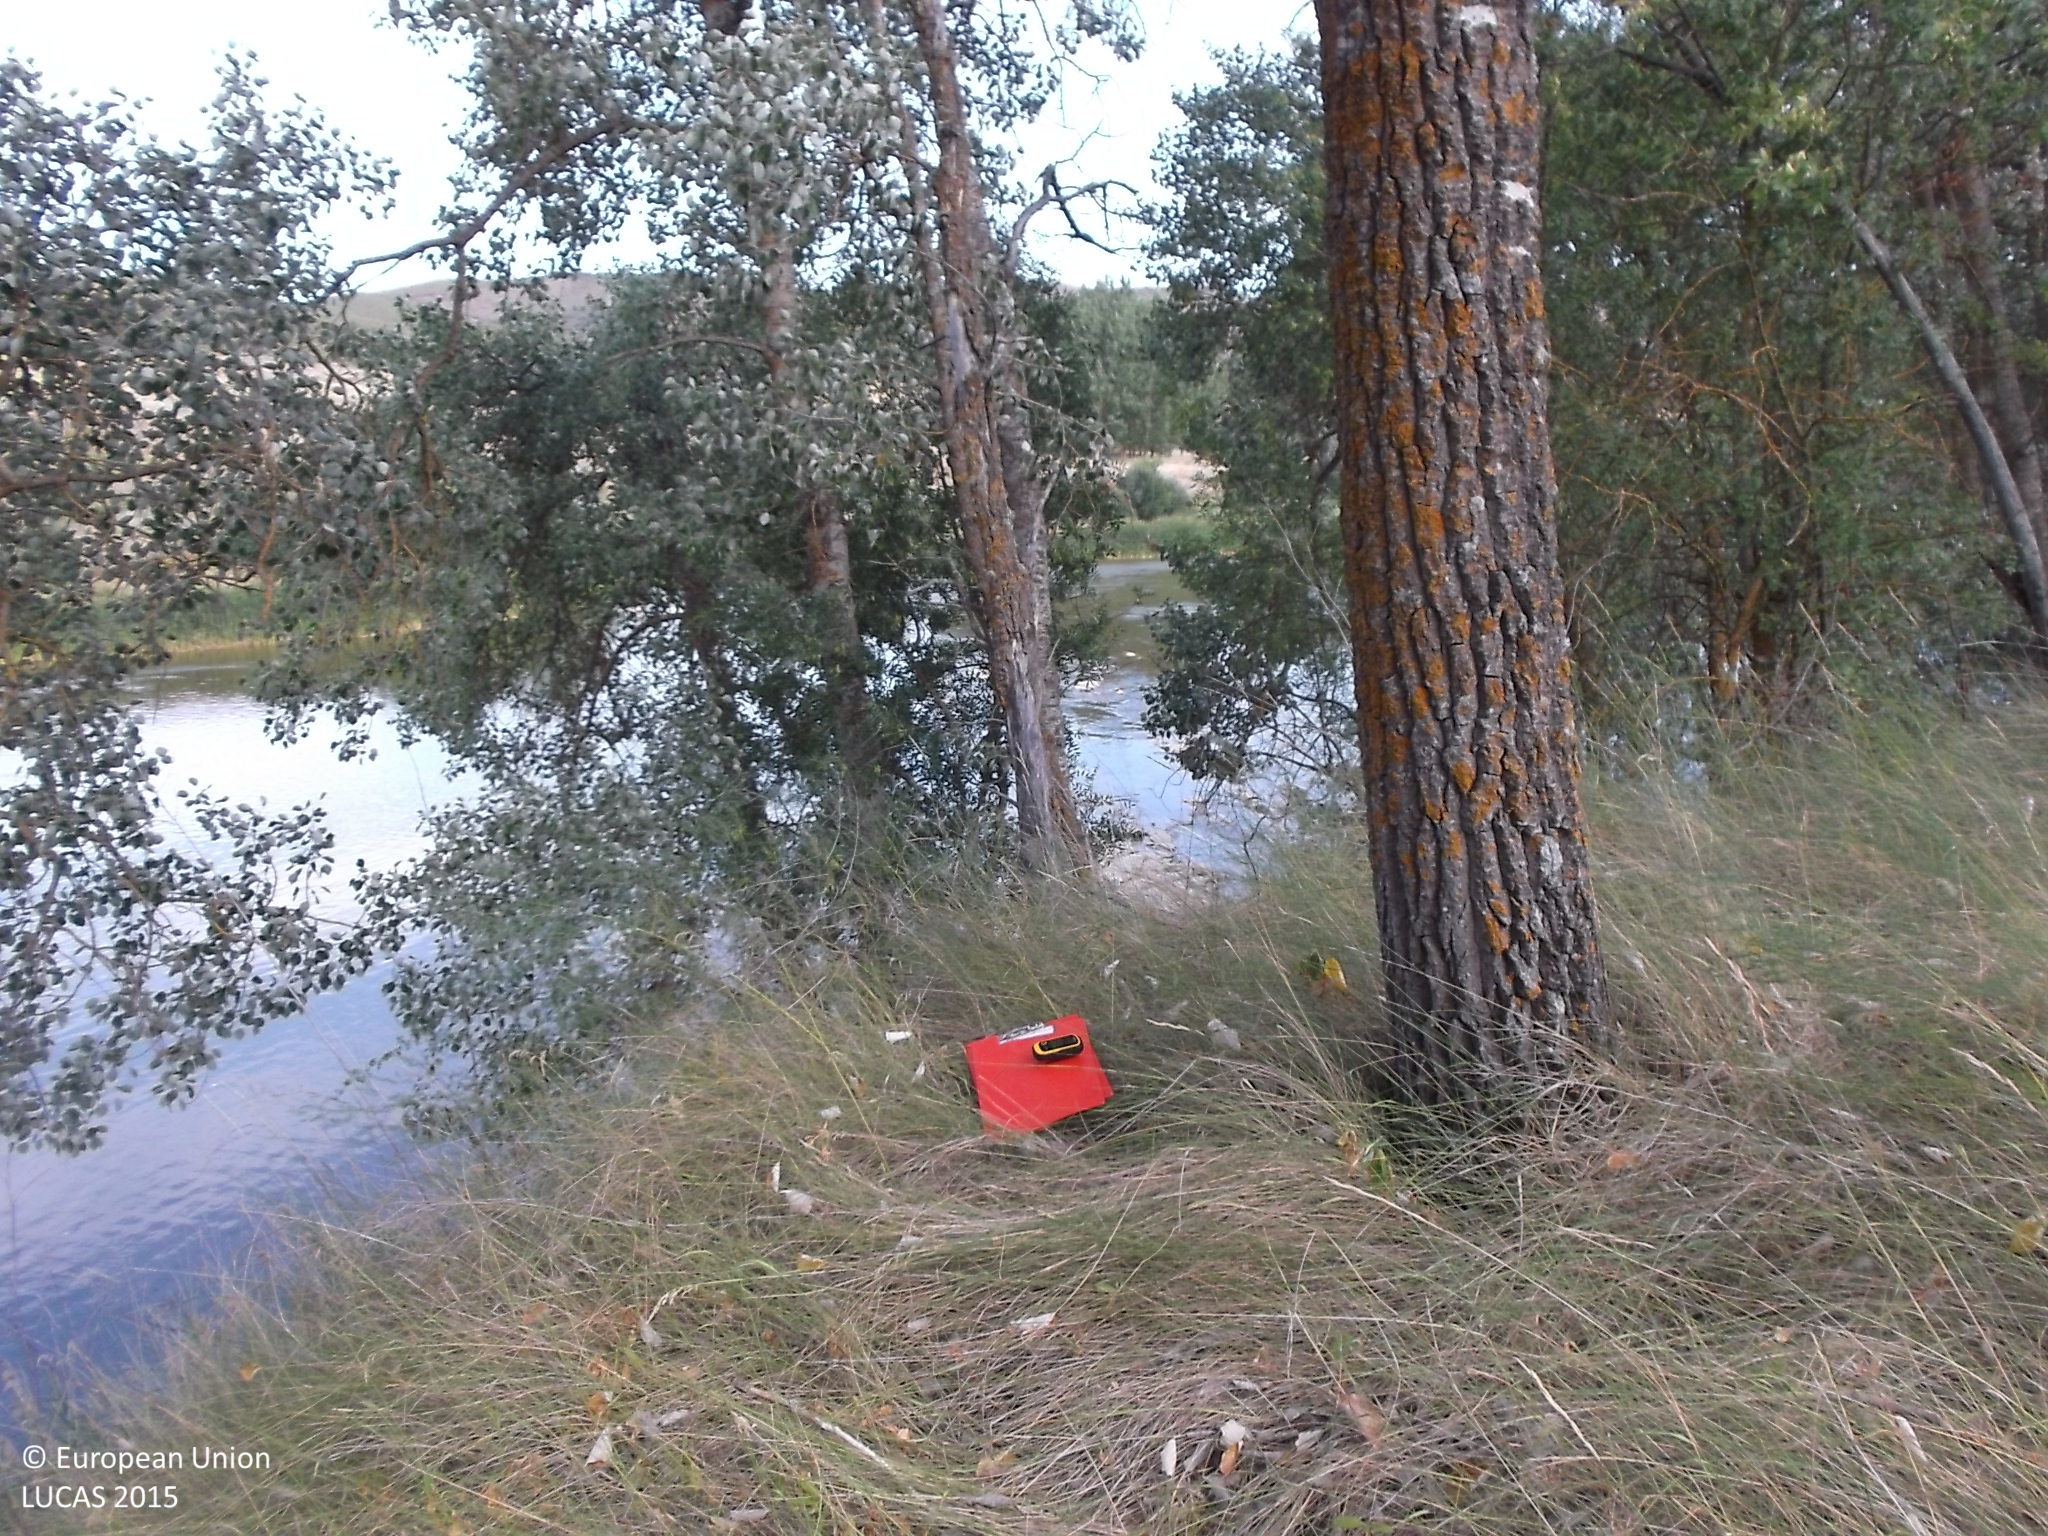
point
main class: Woodland
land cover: Broadleaved woodland
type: thermophilous deciduous forest
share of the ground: 50 - 75 %
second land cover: Grassland without tree/shrub cover
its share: 25 - 50 %
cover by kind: broadleaved forest trees 60 %, herbaceous plants 40 %
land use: Forestry
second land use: Agriculture (excluding fallow land and kitchen gardens)
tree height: > 5 m
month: July
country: ES
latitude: 41.4828
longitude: -5.8858
